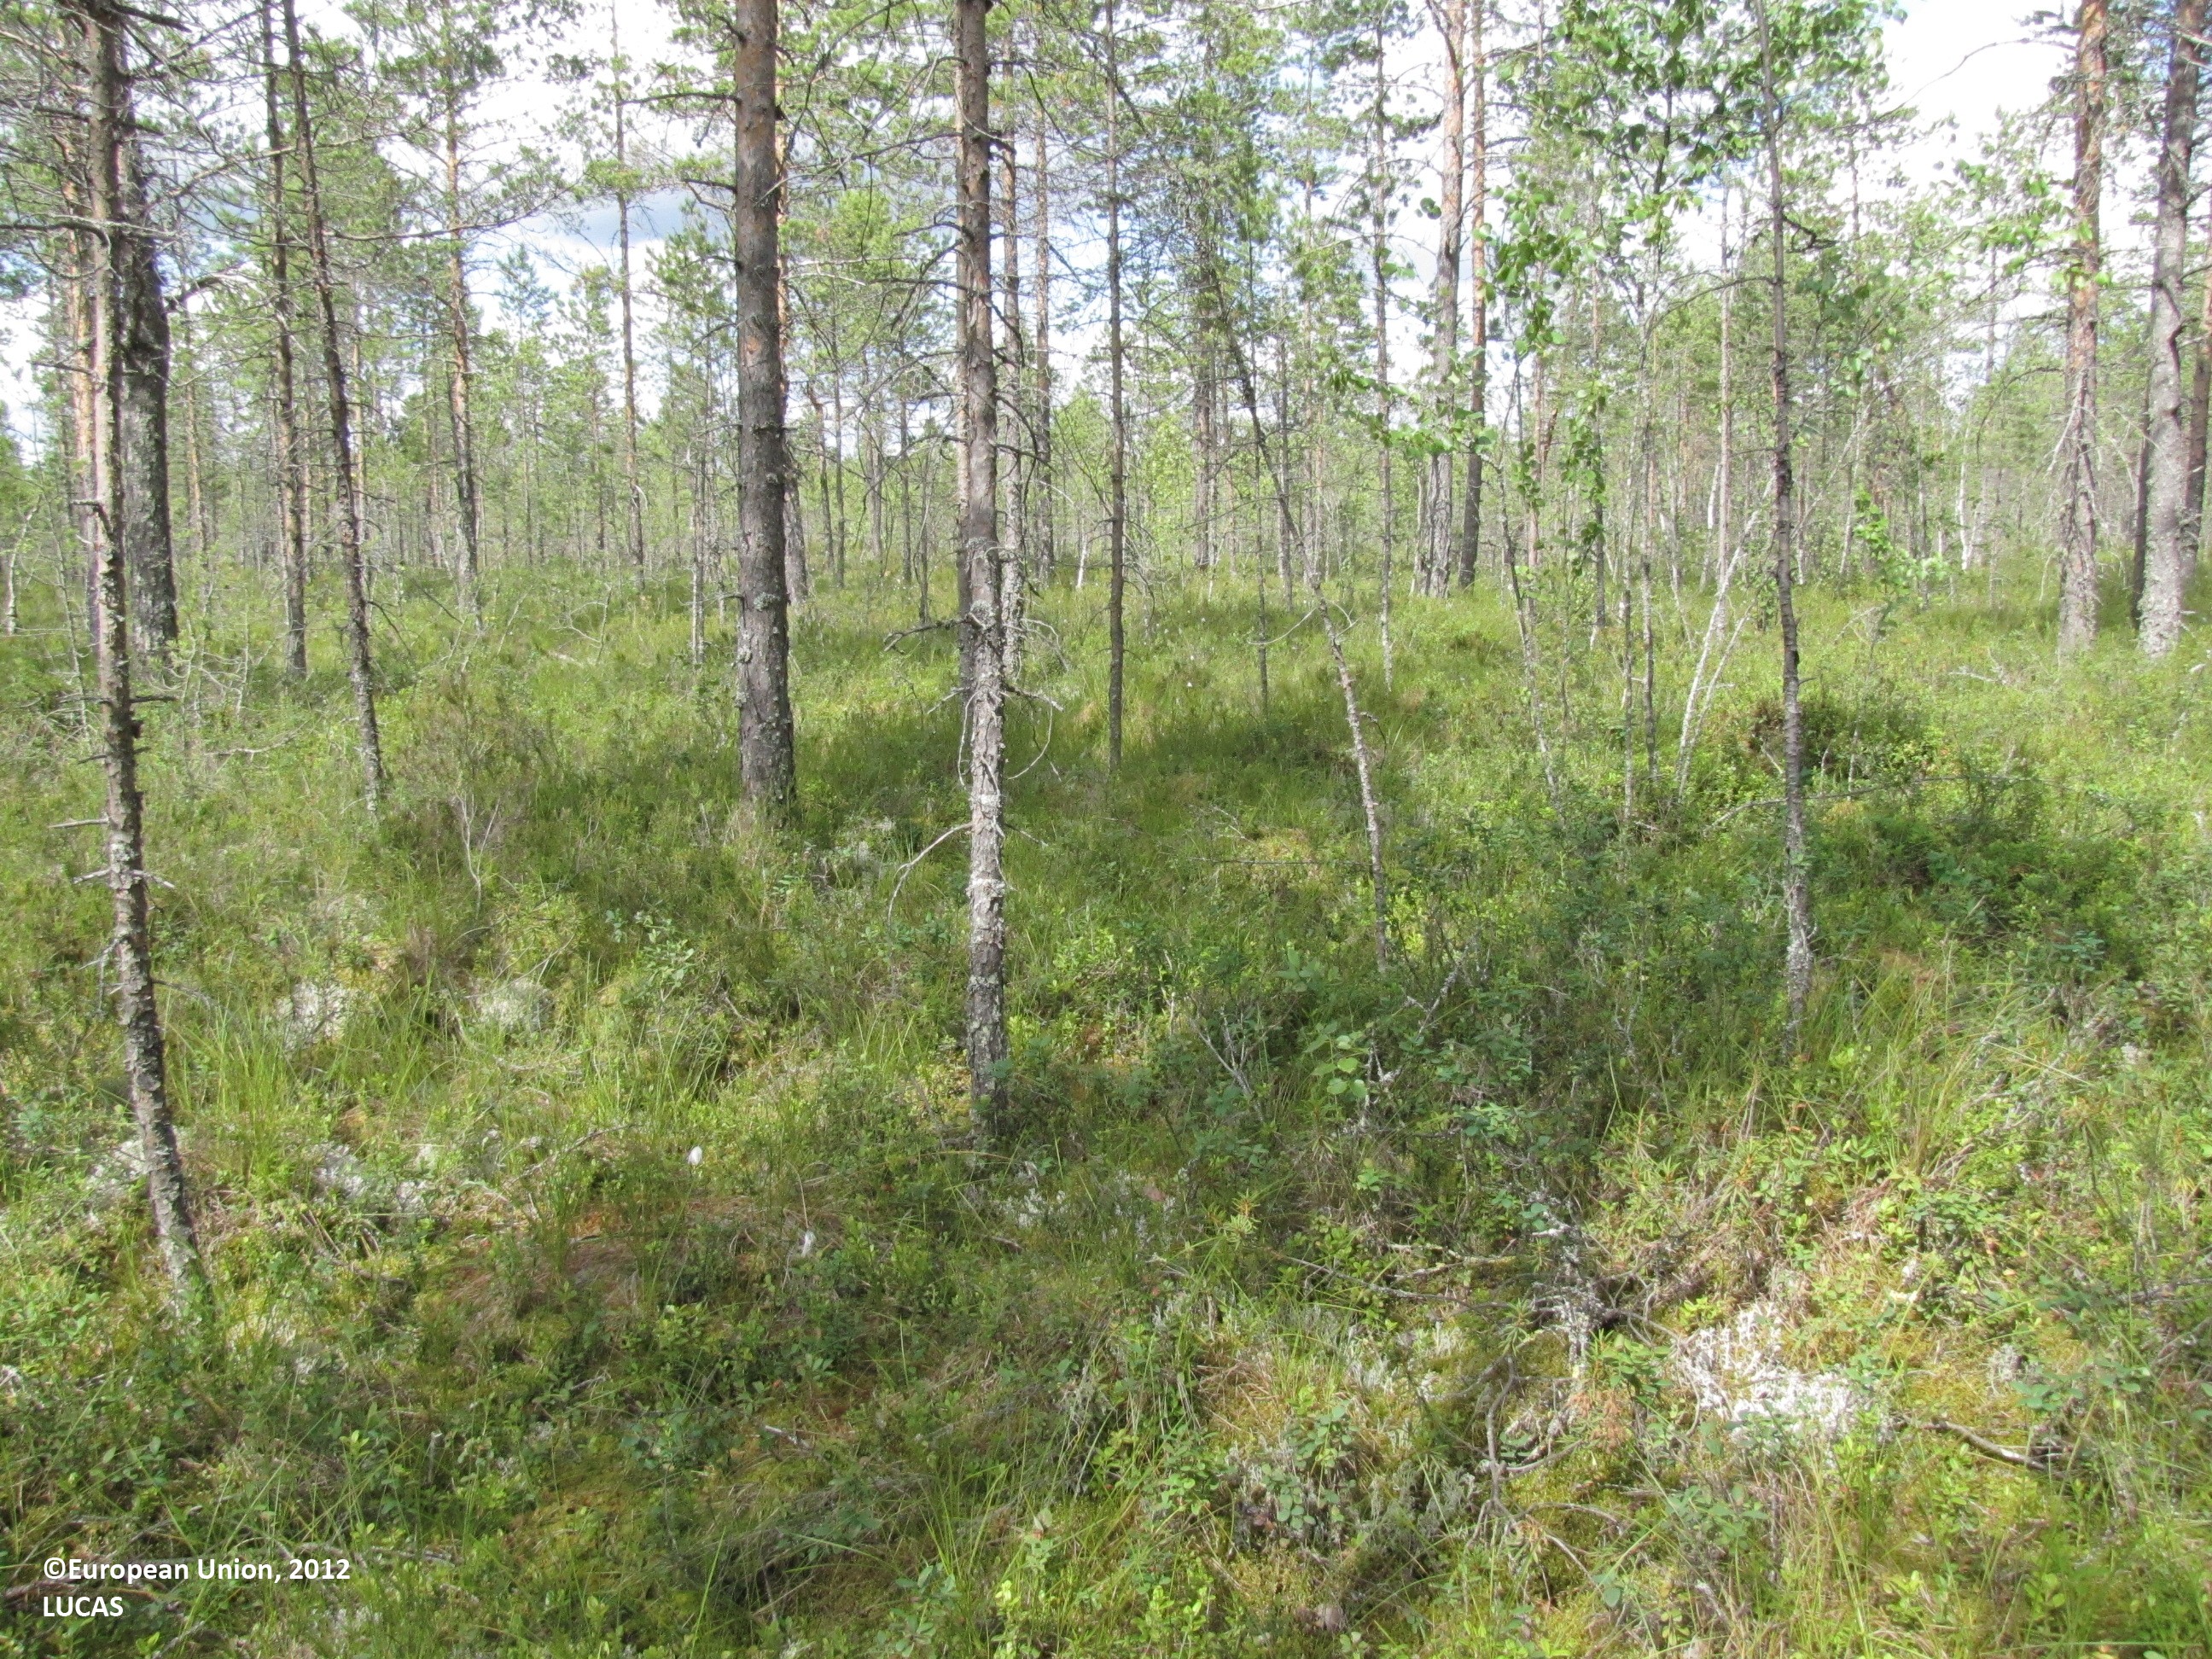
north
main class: Woodland
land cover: Pine dominated coniferous woodland
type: boreal forest
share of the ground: 50 - 75 %
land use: Forestry
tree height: > 5 m
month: July
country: FI
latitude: 62.6306
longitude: 23.2265
